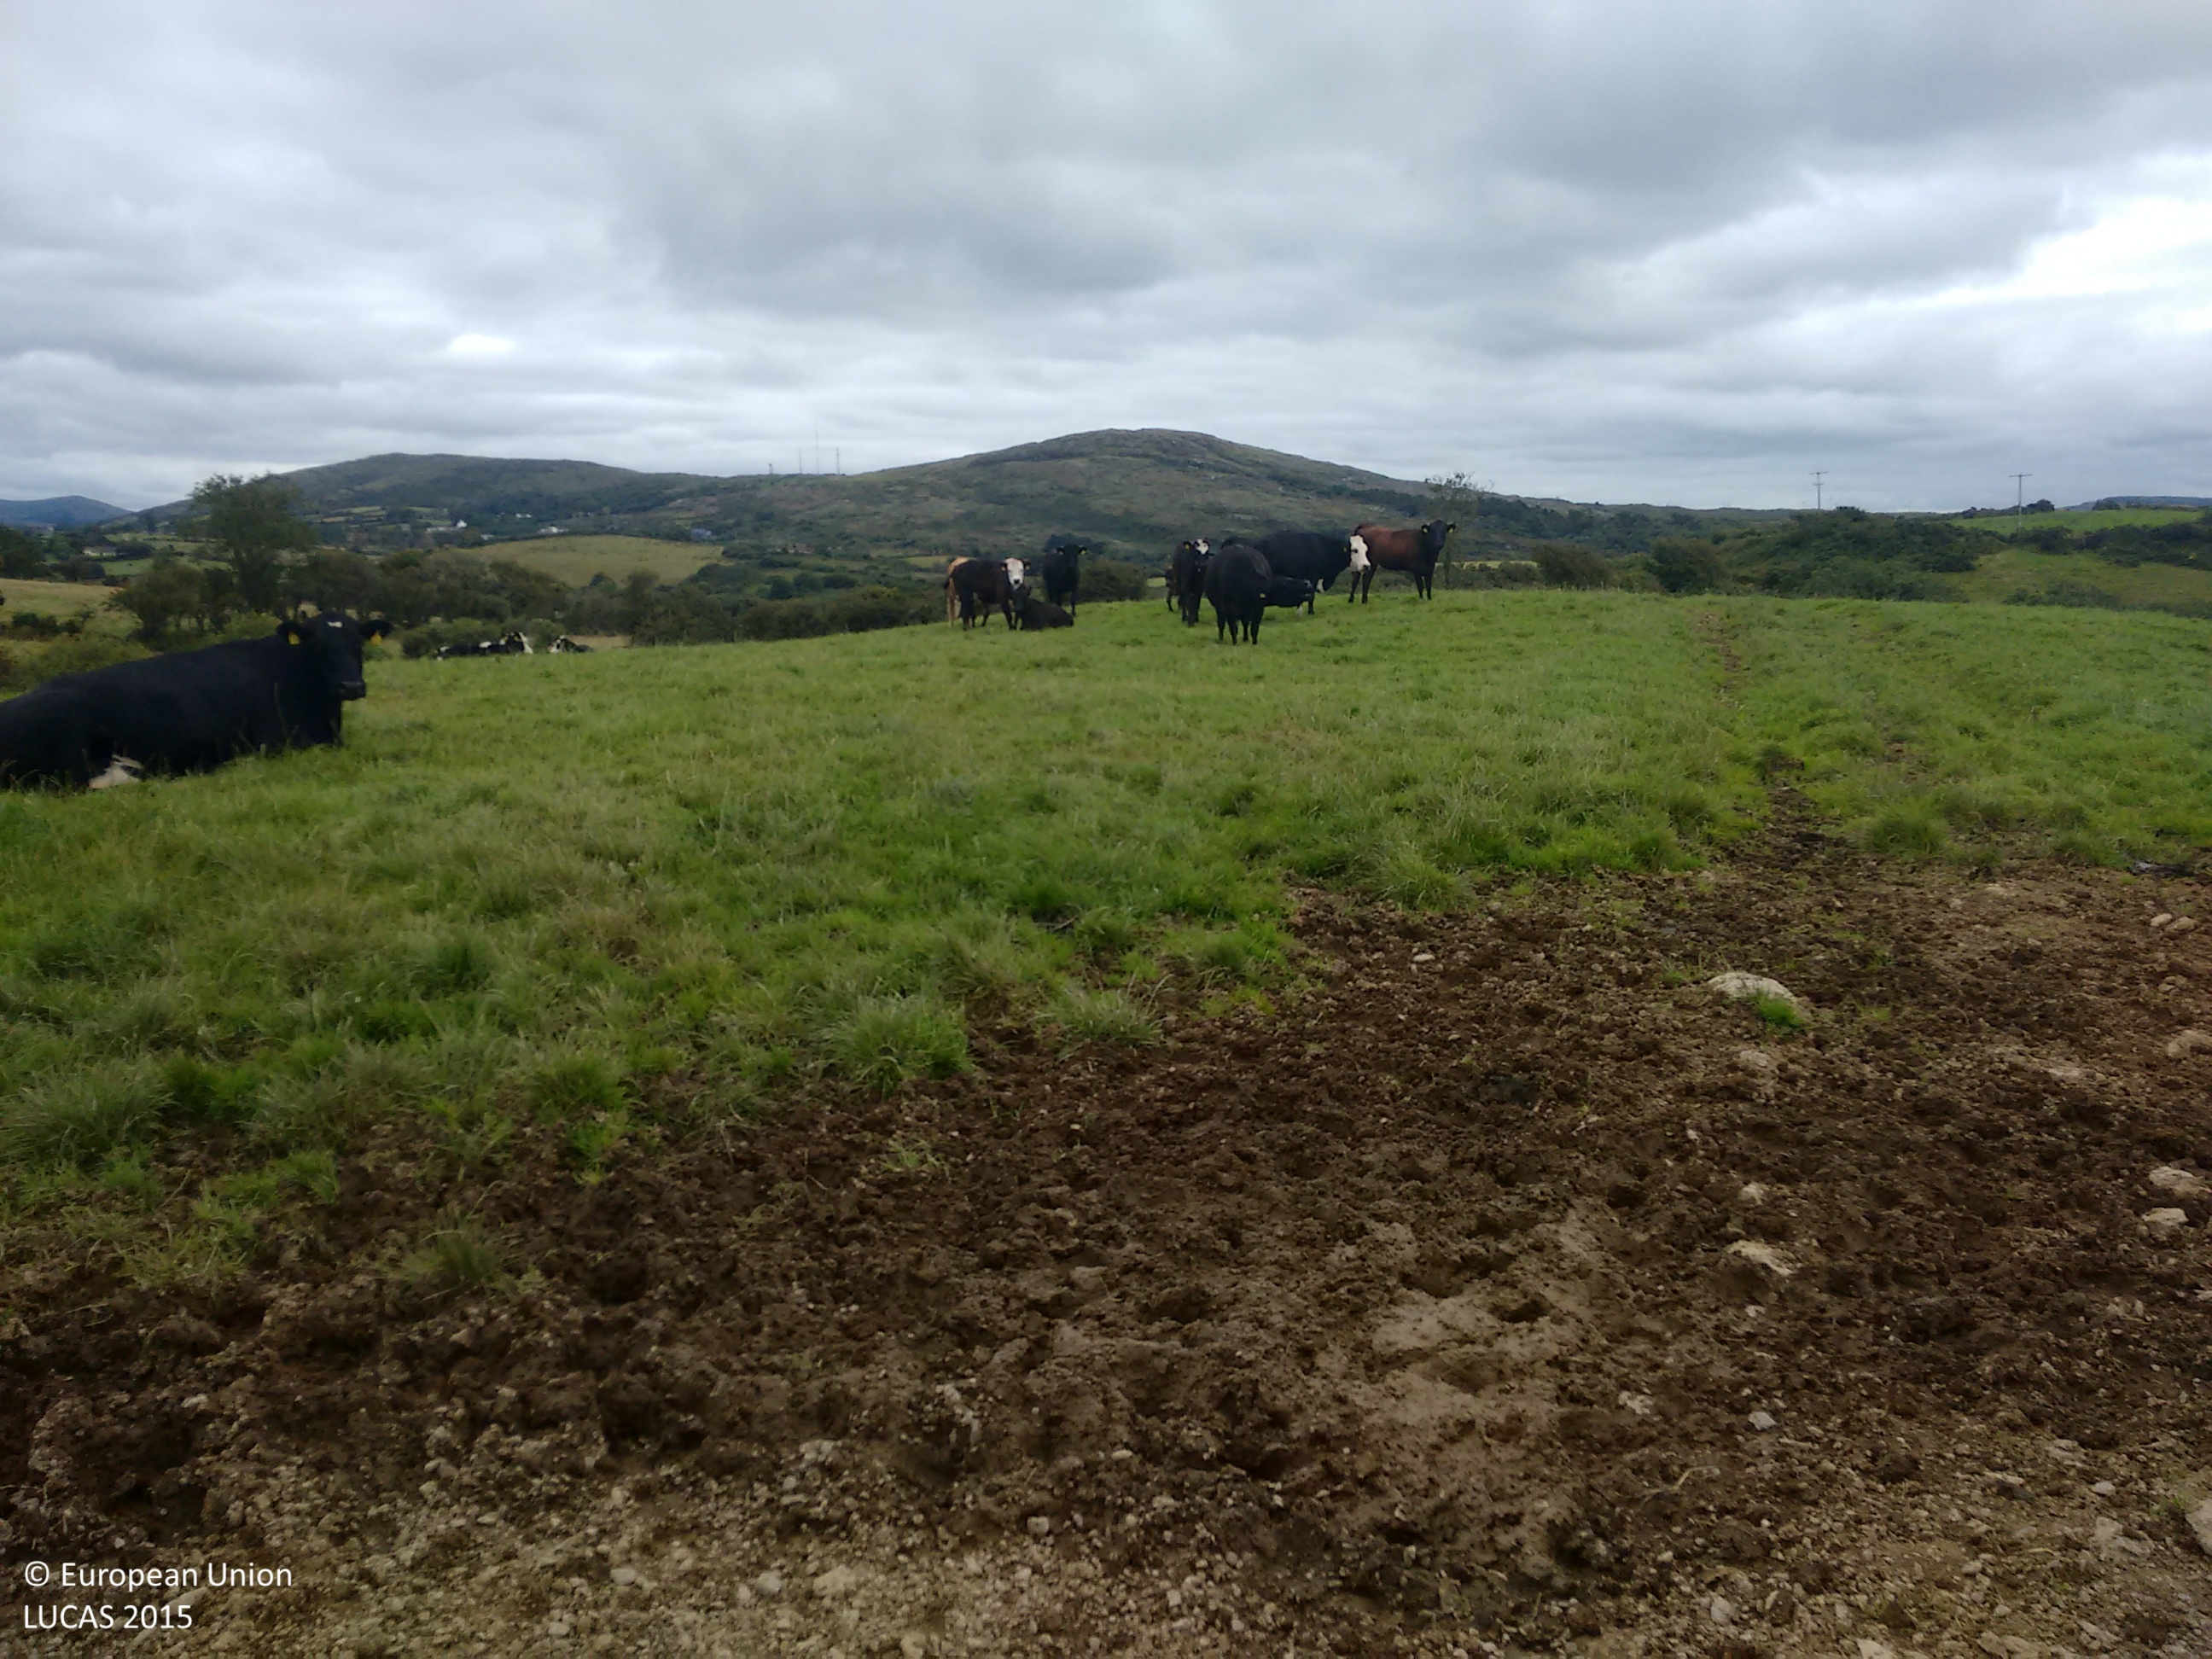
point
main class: Grassland
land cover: Grassland without tree/shrub cover
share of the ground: > 75 %
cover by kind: herbaceous plants 100 %
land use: Agriculture (excluding fallow land and kitchen gardens)
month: August
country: IE
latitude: 51.6669
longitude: -9.4761
